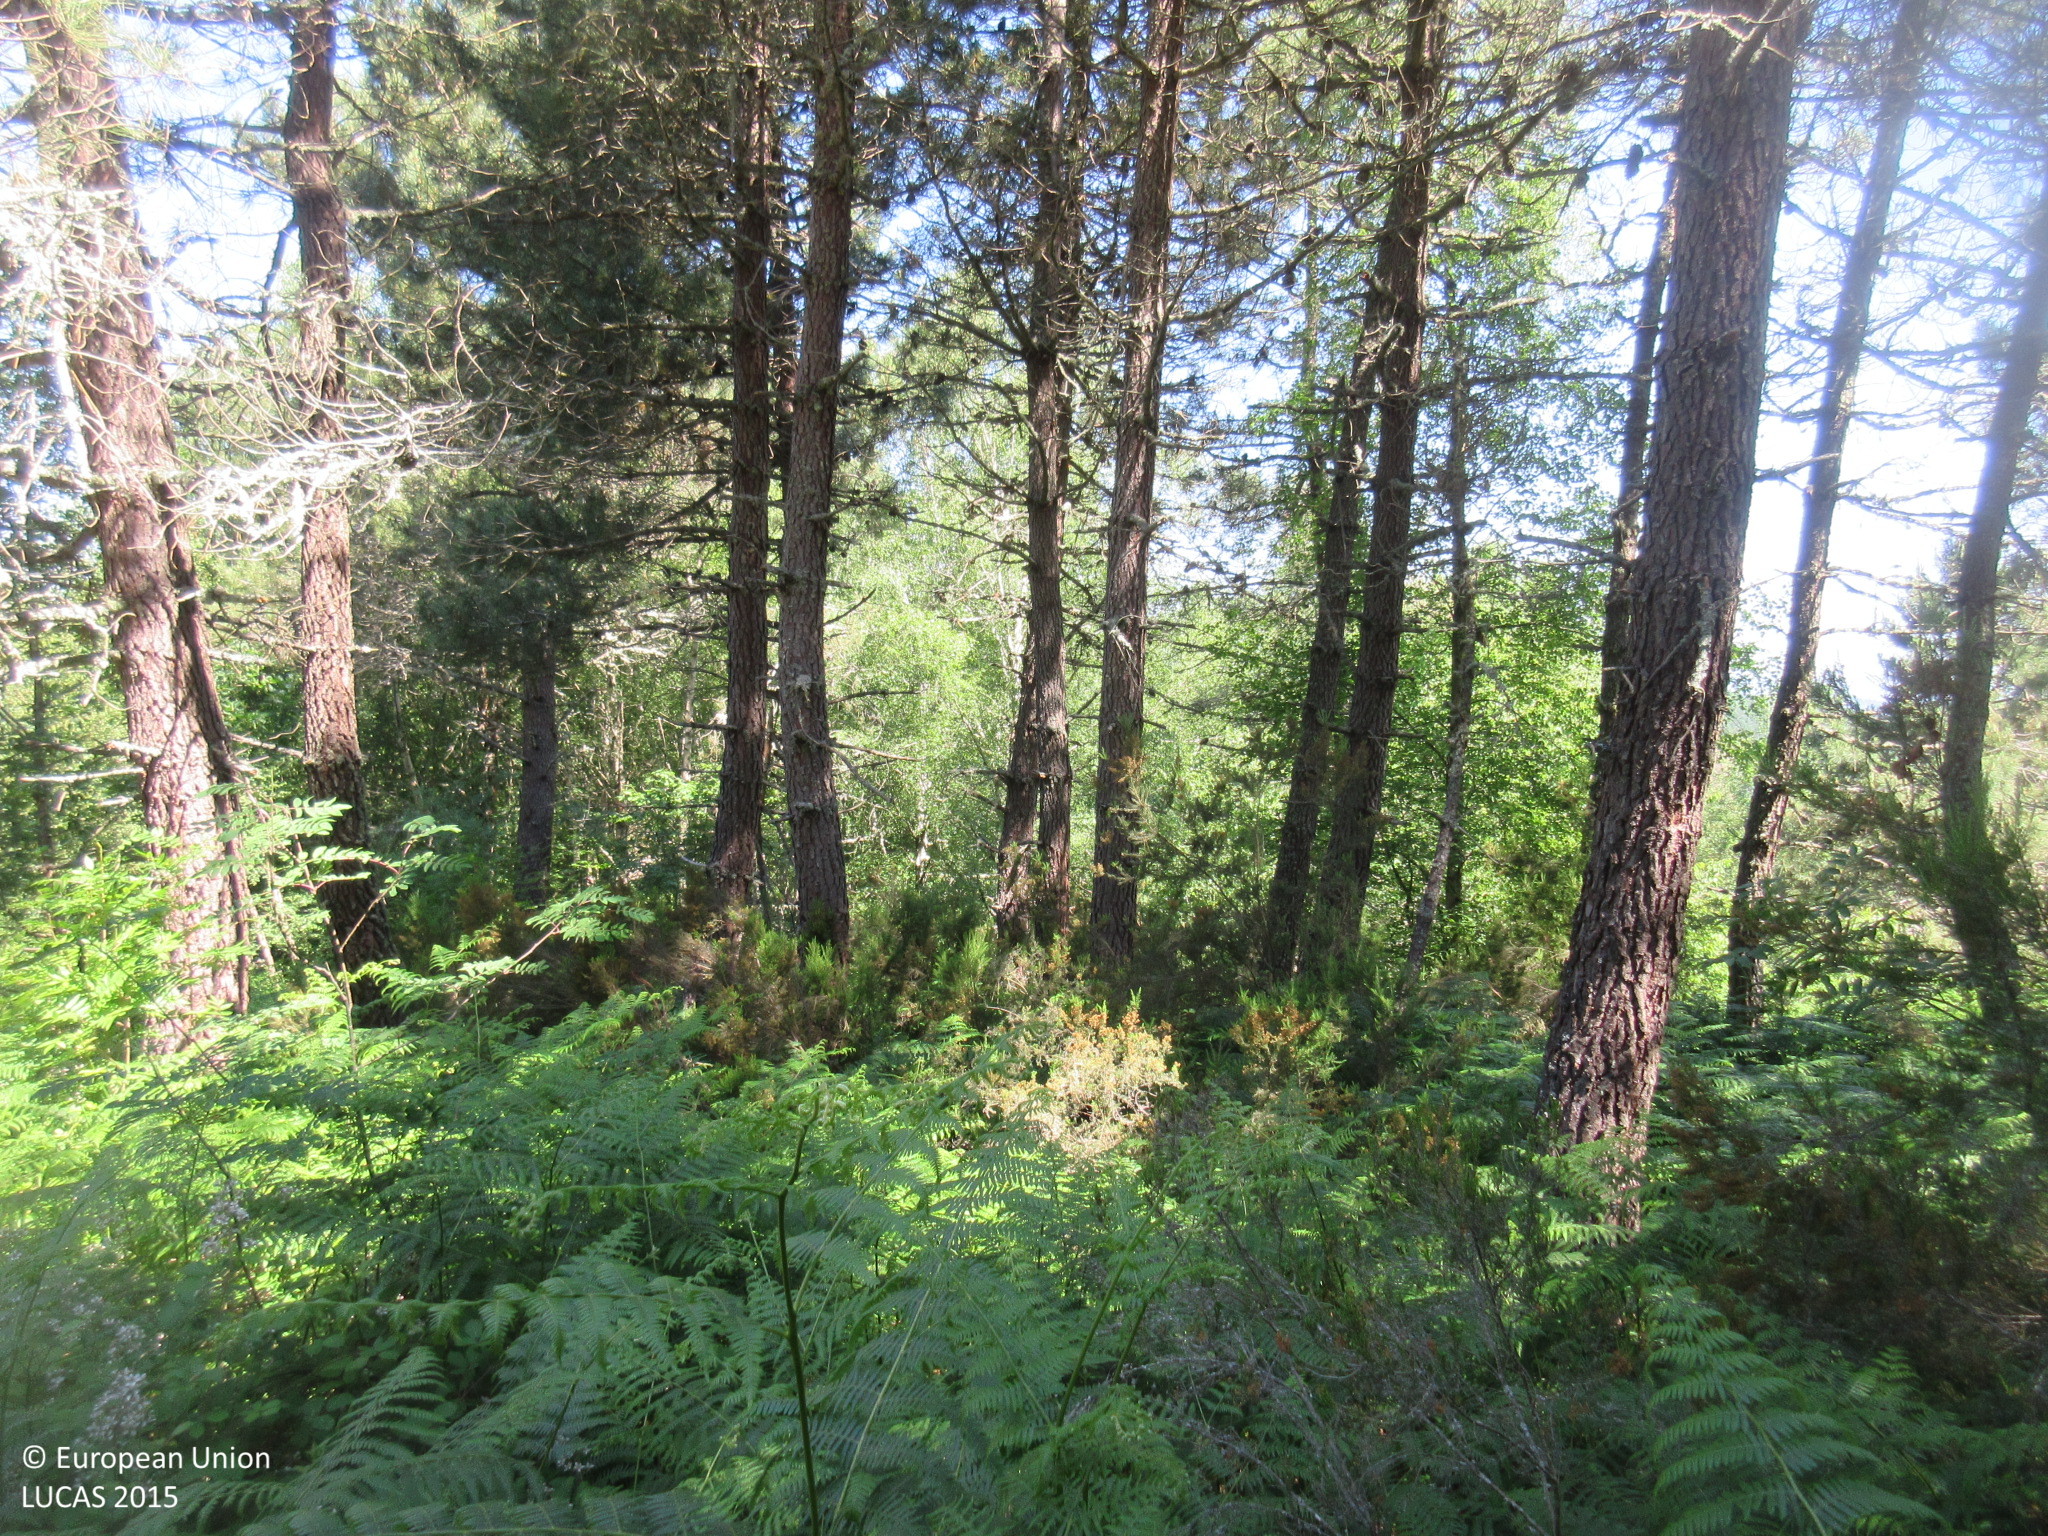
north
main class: Woodland
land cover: Pine dominated coniferous woodland
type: hemiboreal forest and nemoral coniferous forest and mixed broadleaved-coniferous forest
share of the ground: > 75 %
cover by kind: coniferous forest trees 95 %, shrubs 5 %
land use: Forestry
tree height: > 5 m
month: June
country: ES
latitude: 42.9244
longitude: -6.9552
